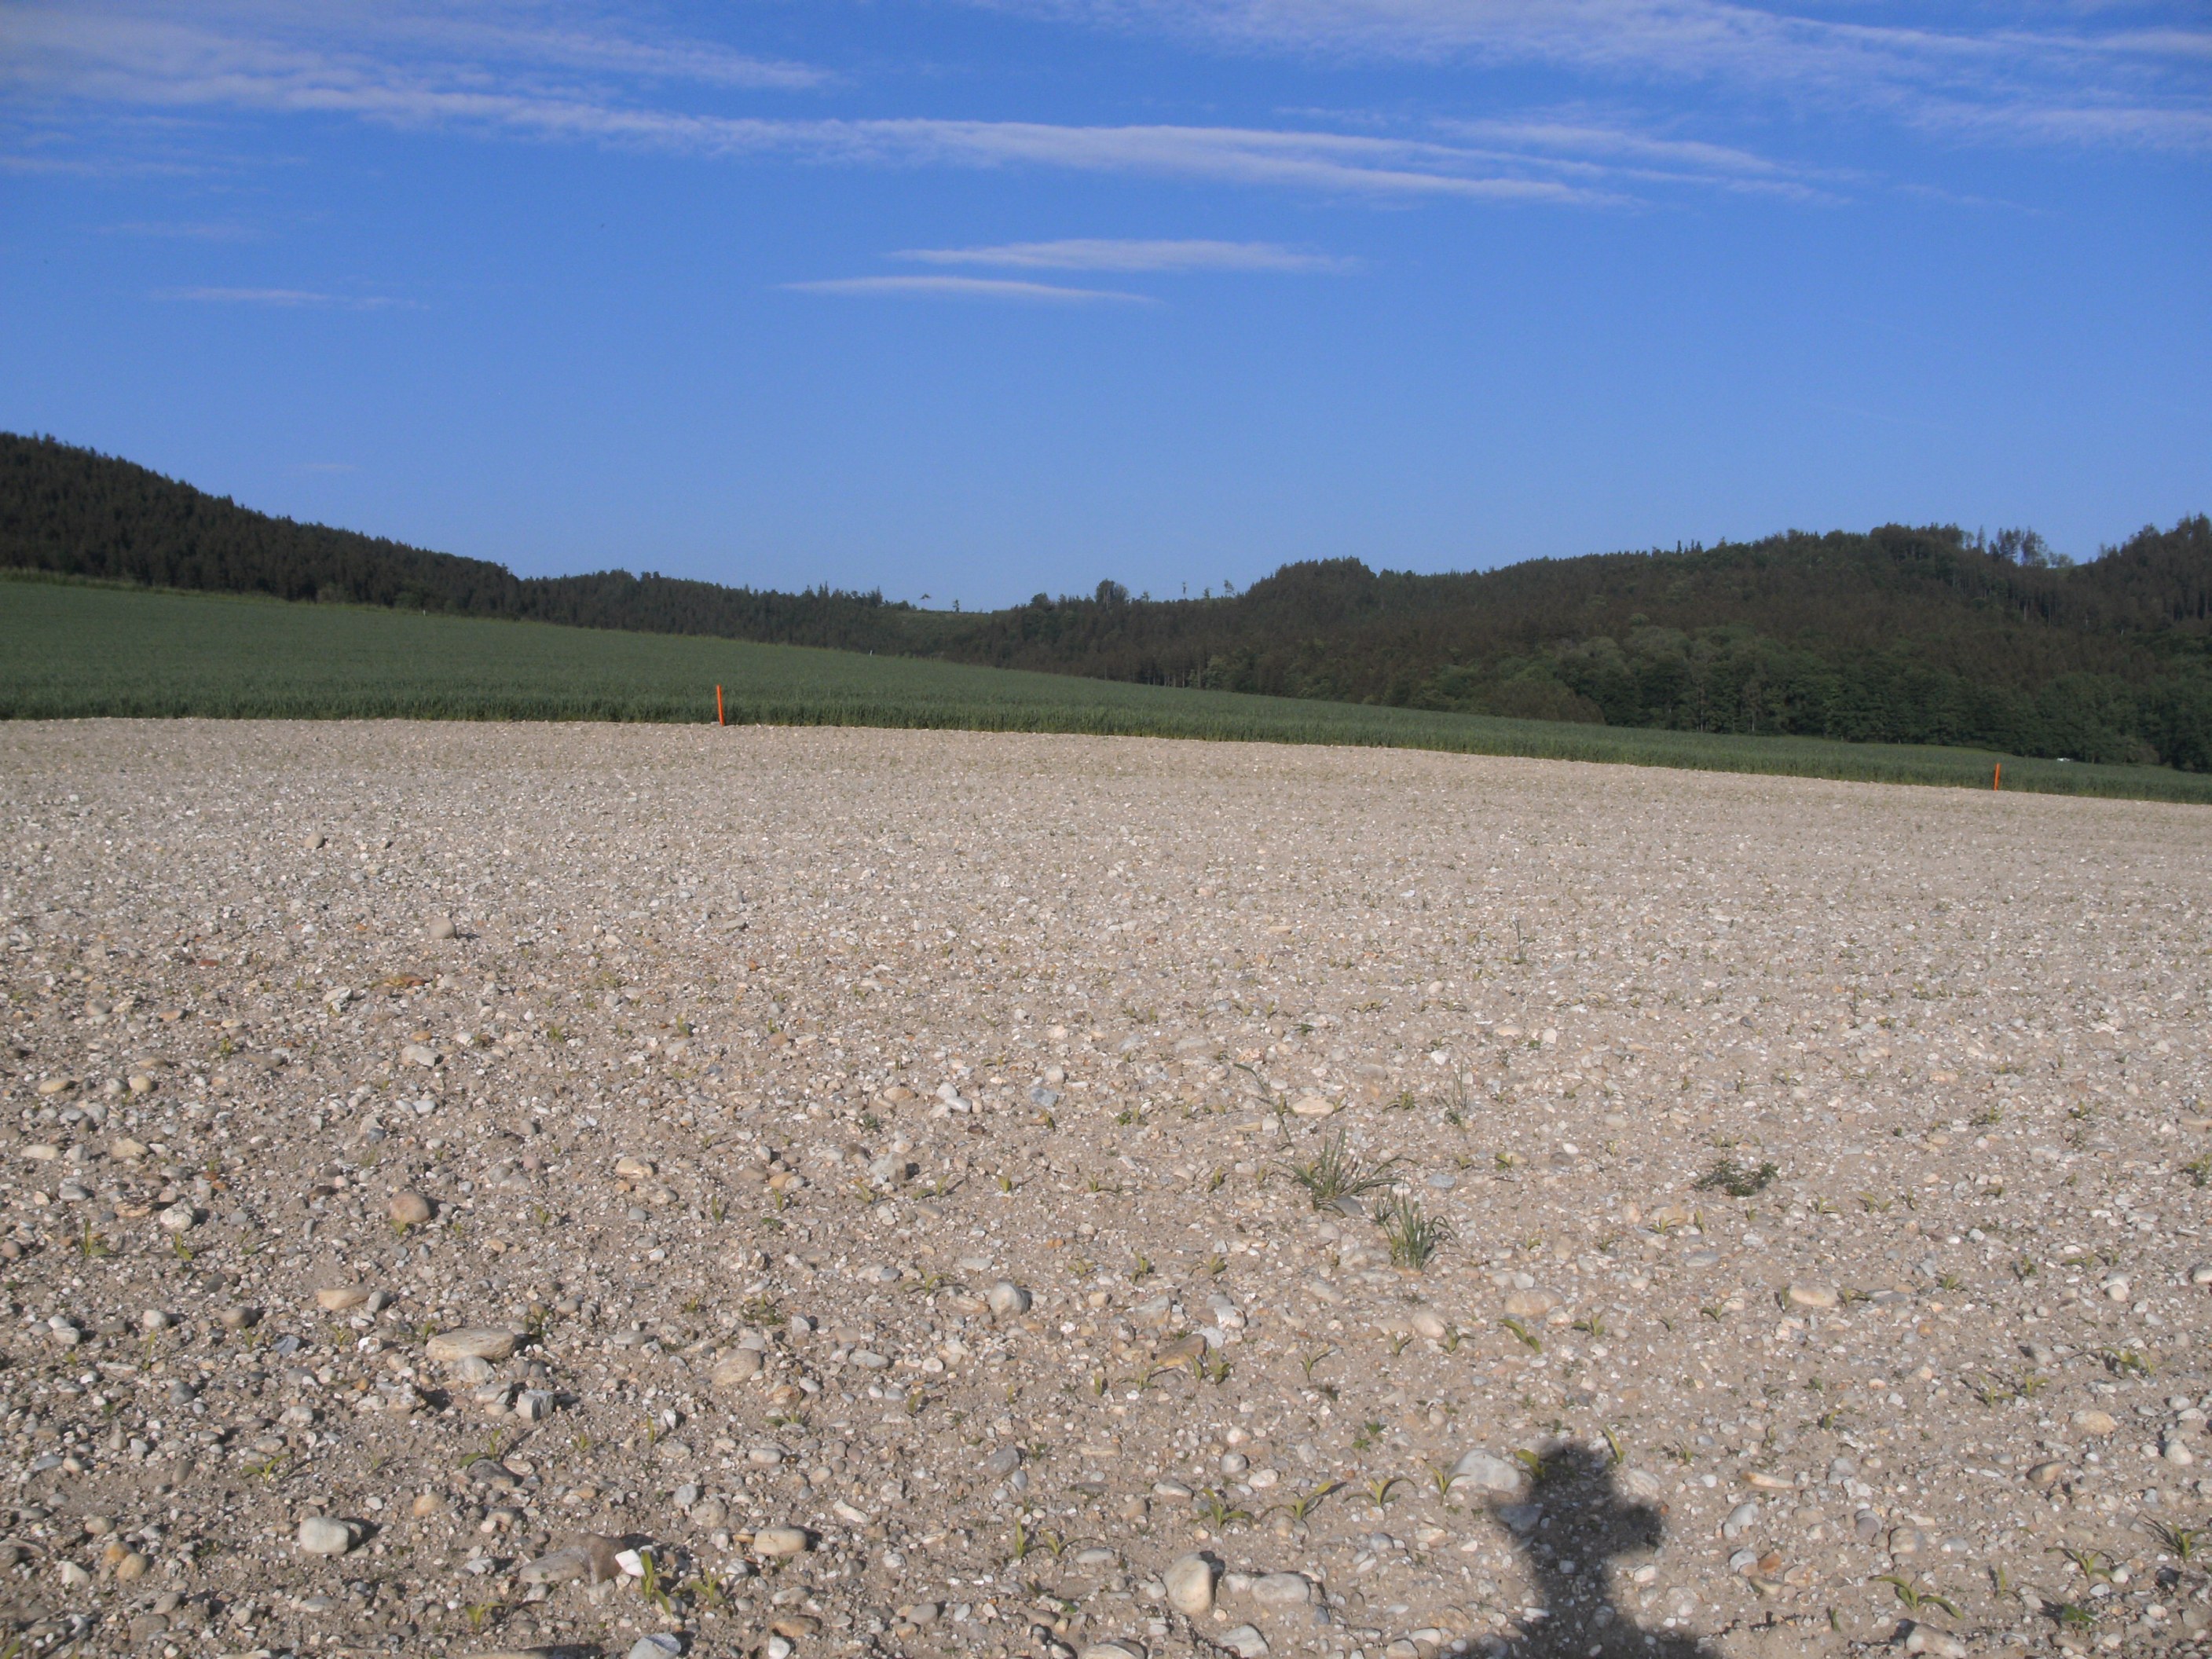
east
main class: Cropland
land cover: Maize
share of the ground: < 10 %
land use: Agriculture (excluding fallow land and kitchen gardens)
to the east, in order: Maize; Triticale; Tracks; Grass margins; Other bare soil; Temporary grasslands
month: May
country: AT
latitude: 48.1651
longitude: 13.5892
